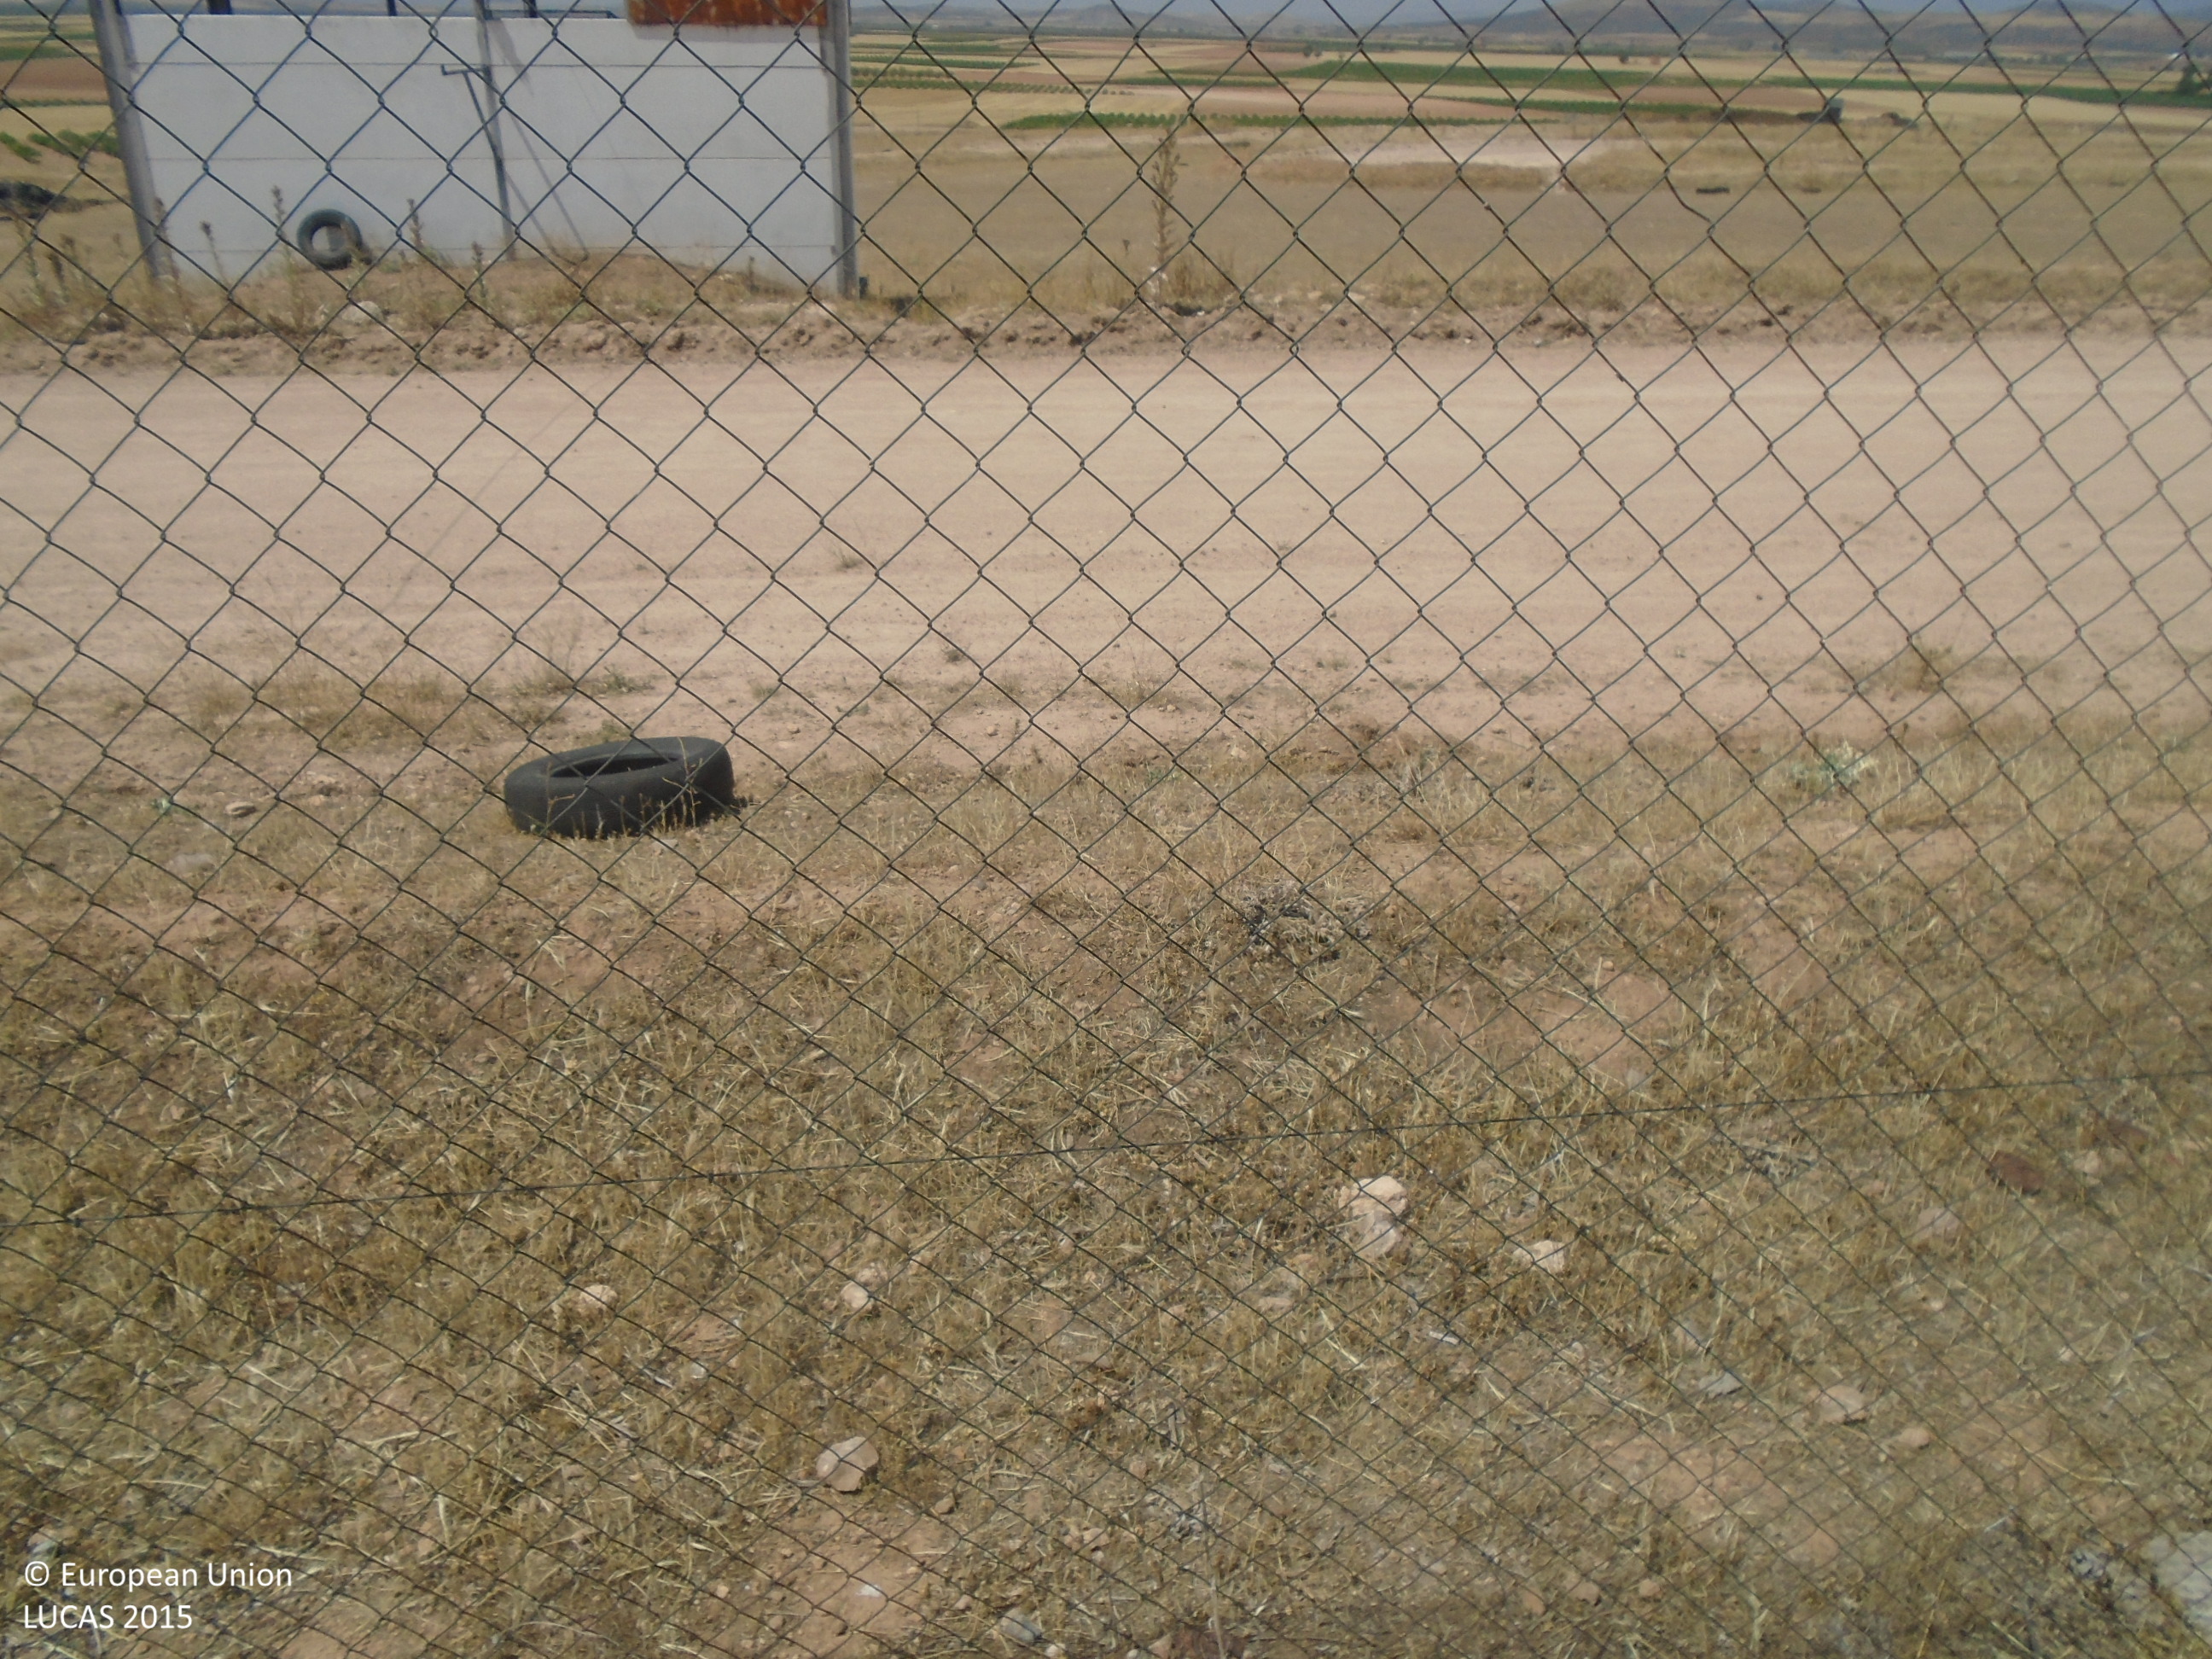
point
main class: Grassland
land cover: Grassland without tree/shrub cover
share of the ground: > 75 %
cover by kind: herbaceous plants 100 %
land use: Agriculture (excluding fallow land and kitchen gardens)
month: July
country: ES
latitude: 39.4428
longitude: -3.6063
